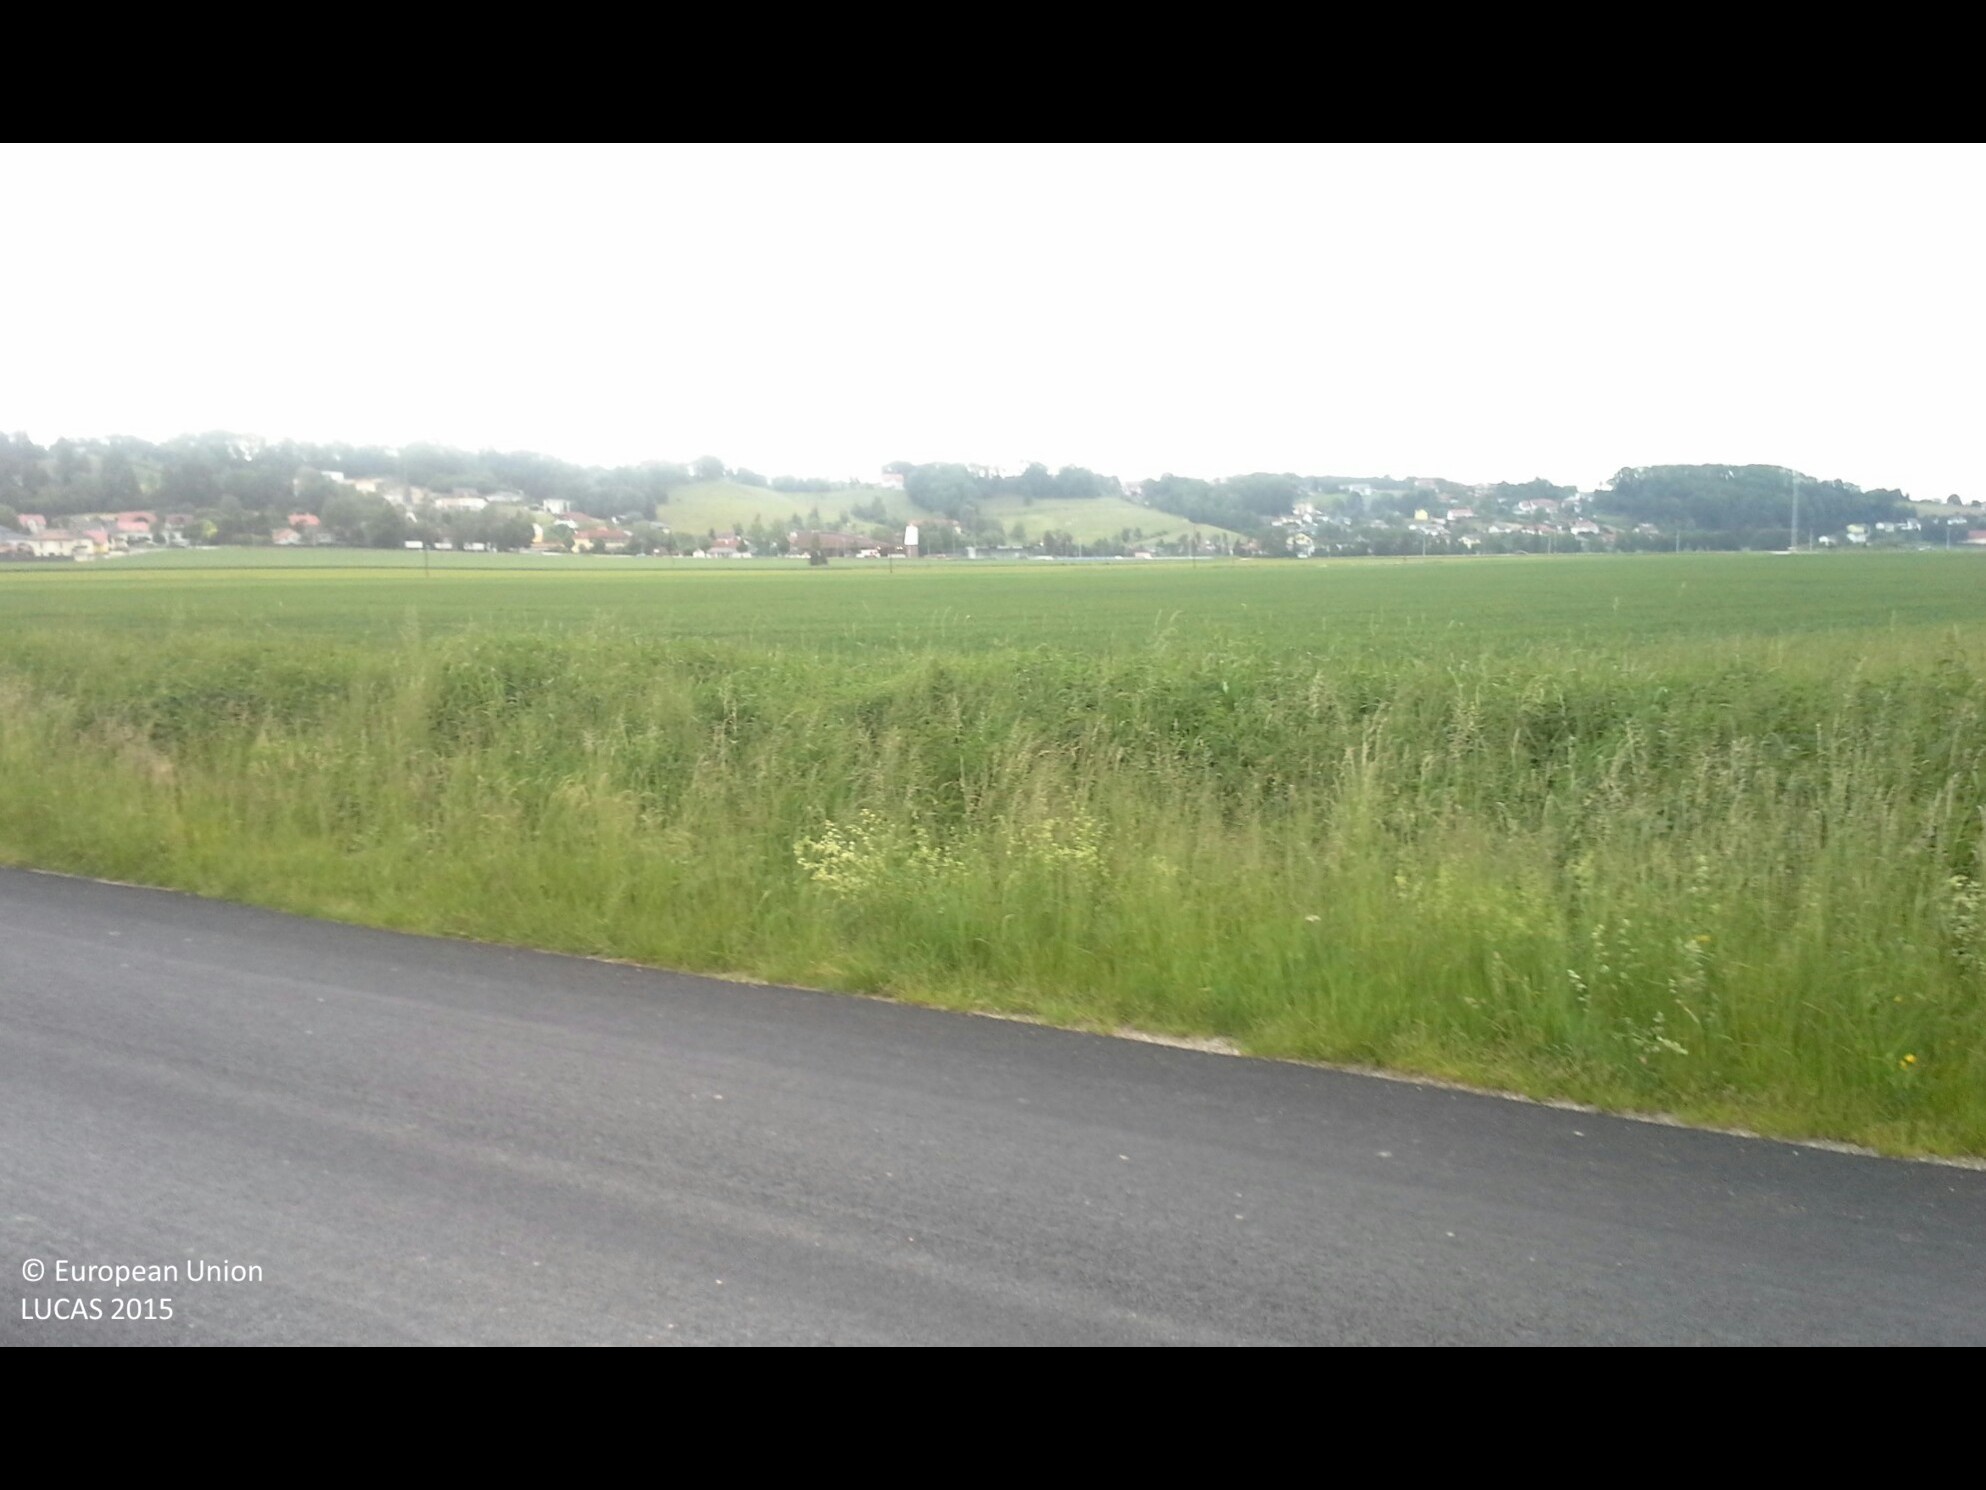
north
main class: Cropland
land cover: Temporary grasslands
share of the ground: > 75 %
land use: Agriculture (excluding fallow land and kitchen gardens)
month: May
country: AT
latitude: 48.0810
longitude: 14.4164
